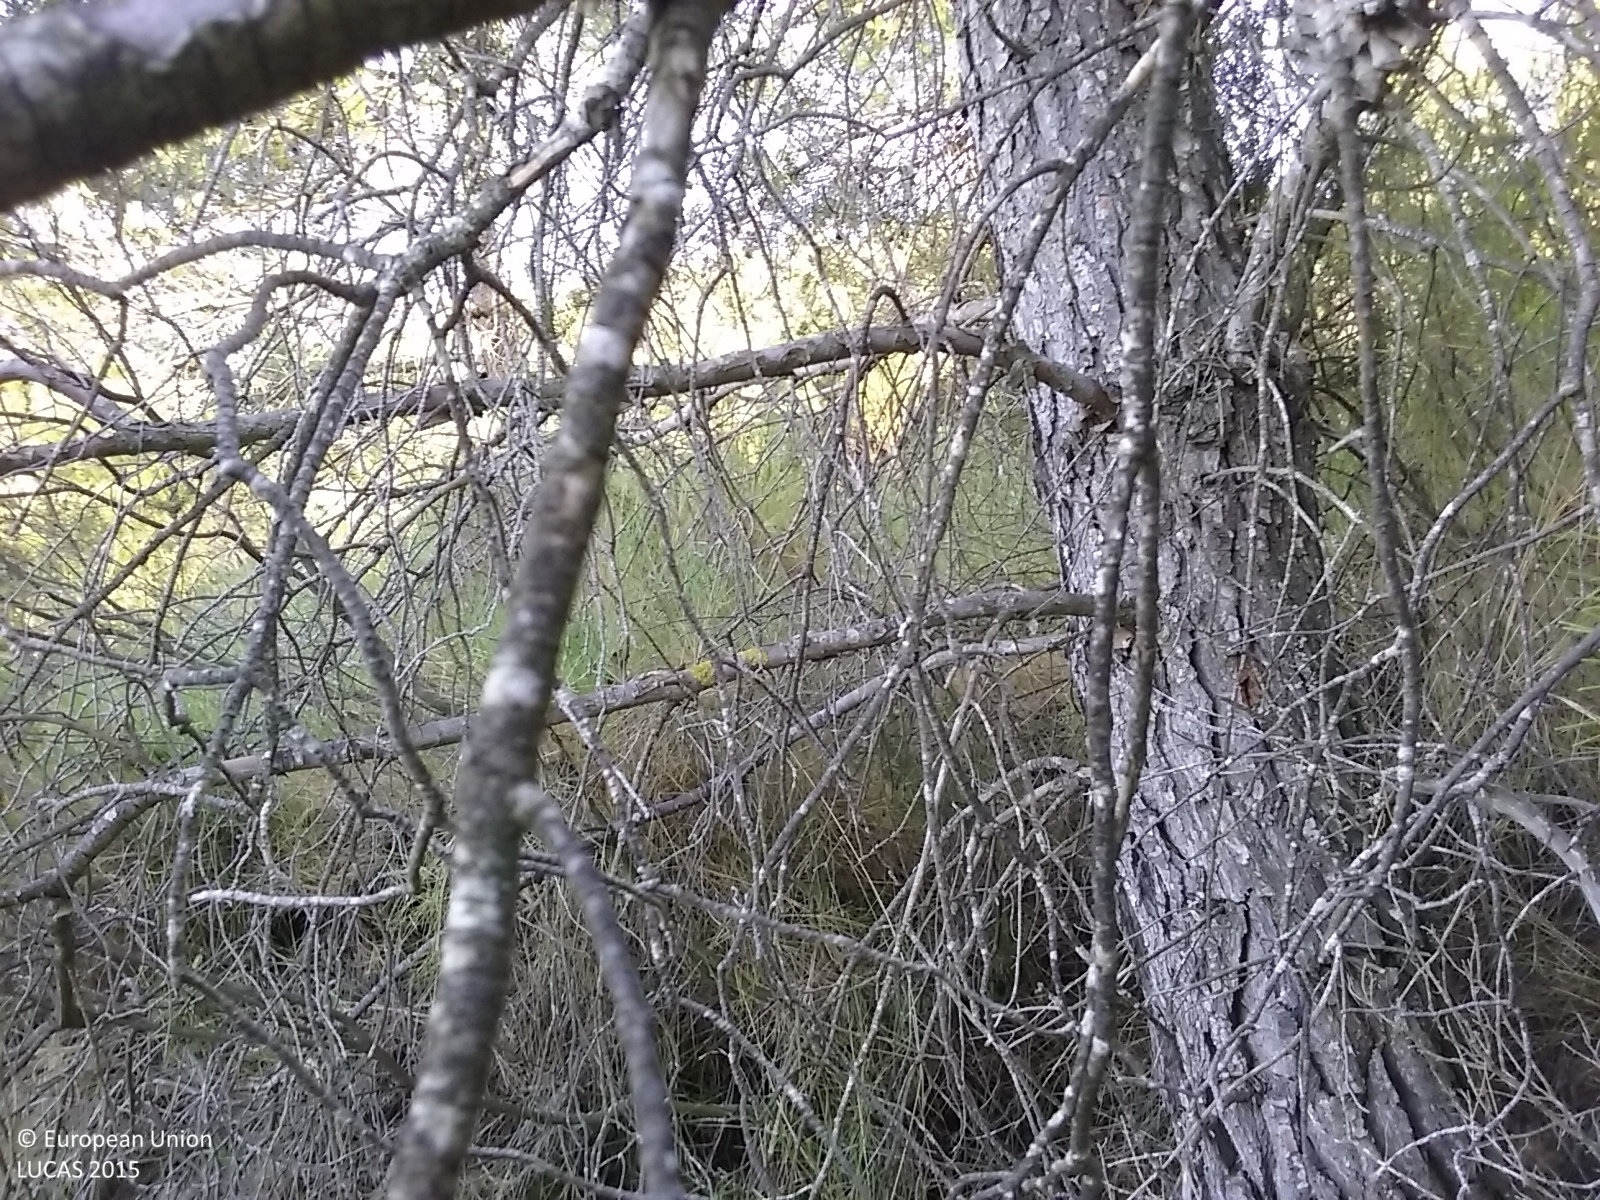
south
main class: Woodland
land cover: Pine dominated coniferous woodland
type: coniferous forest of the mediterranean region
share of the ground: 25 - 50 %
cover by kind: shrubs 75 %, coniferous forest trees 25 %
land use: Semi-natural and natural areas not in use
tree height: > 5 m
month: June
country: ES
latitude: 40.9985
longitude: 0.2307
